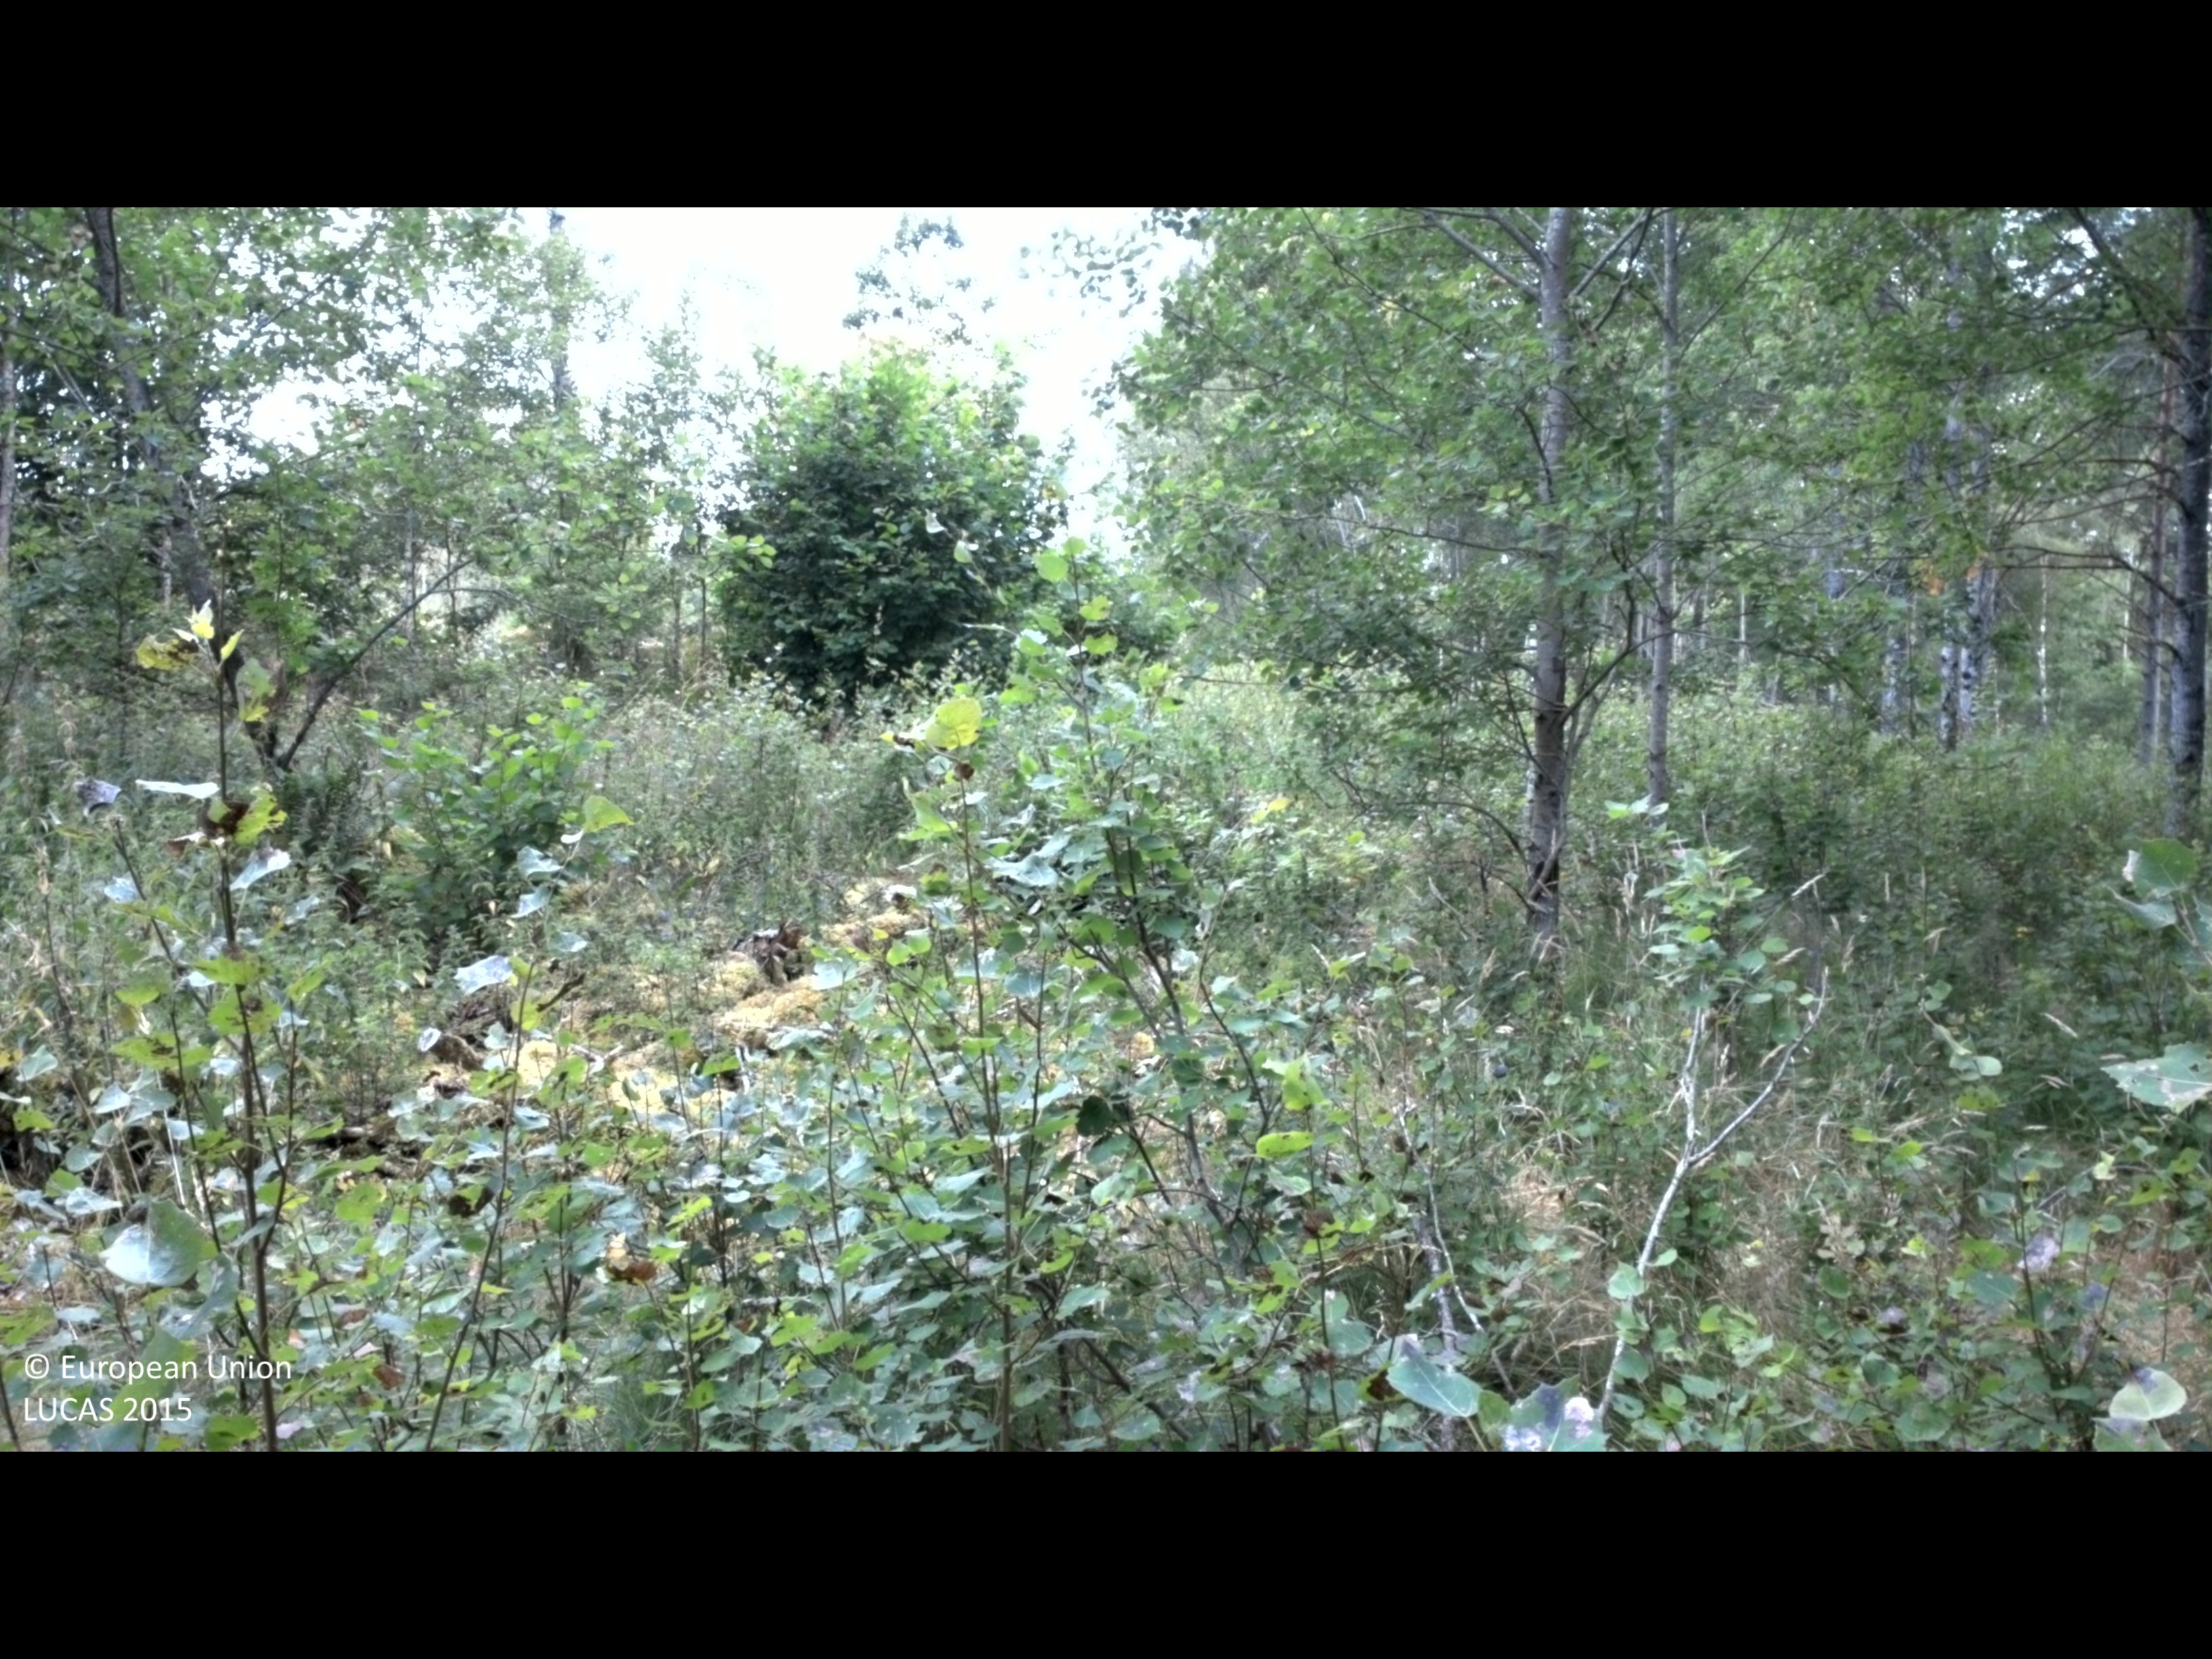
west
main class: Woodland
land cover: Broadleaved woodland
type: hemiboreal forest and nemoral coniferous forest and mixed broadleaved-coniferous forest
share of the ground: 25 - 50 %
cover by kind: broadleaved forest trees 50 %, shrubs 25 %, herbaceous plants 25 %
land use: Forestry
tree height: > 5 m
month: August
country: SE
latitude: 56.7683
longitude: 14.1689
